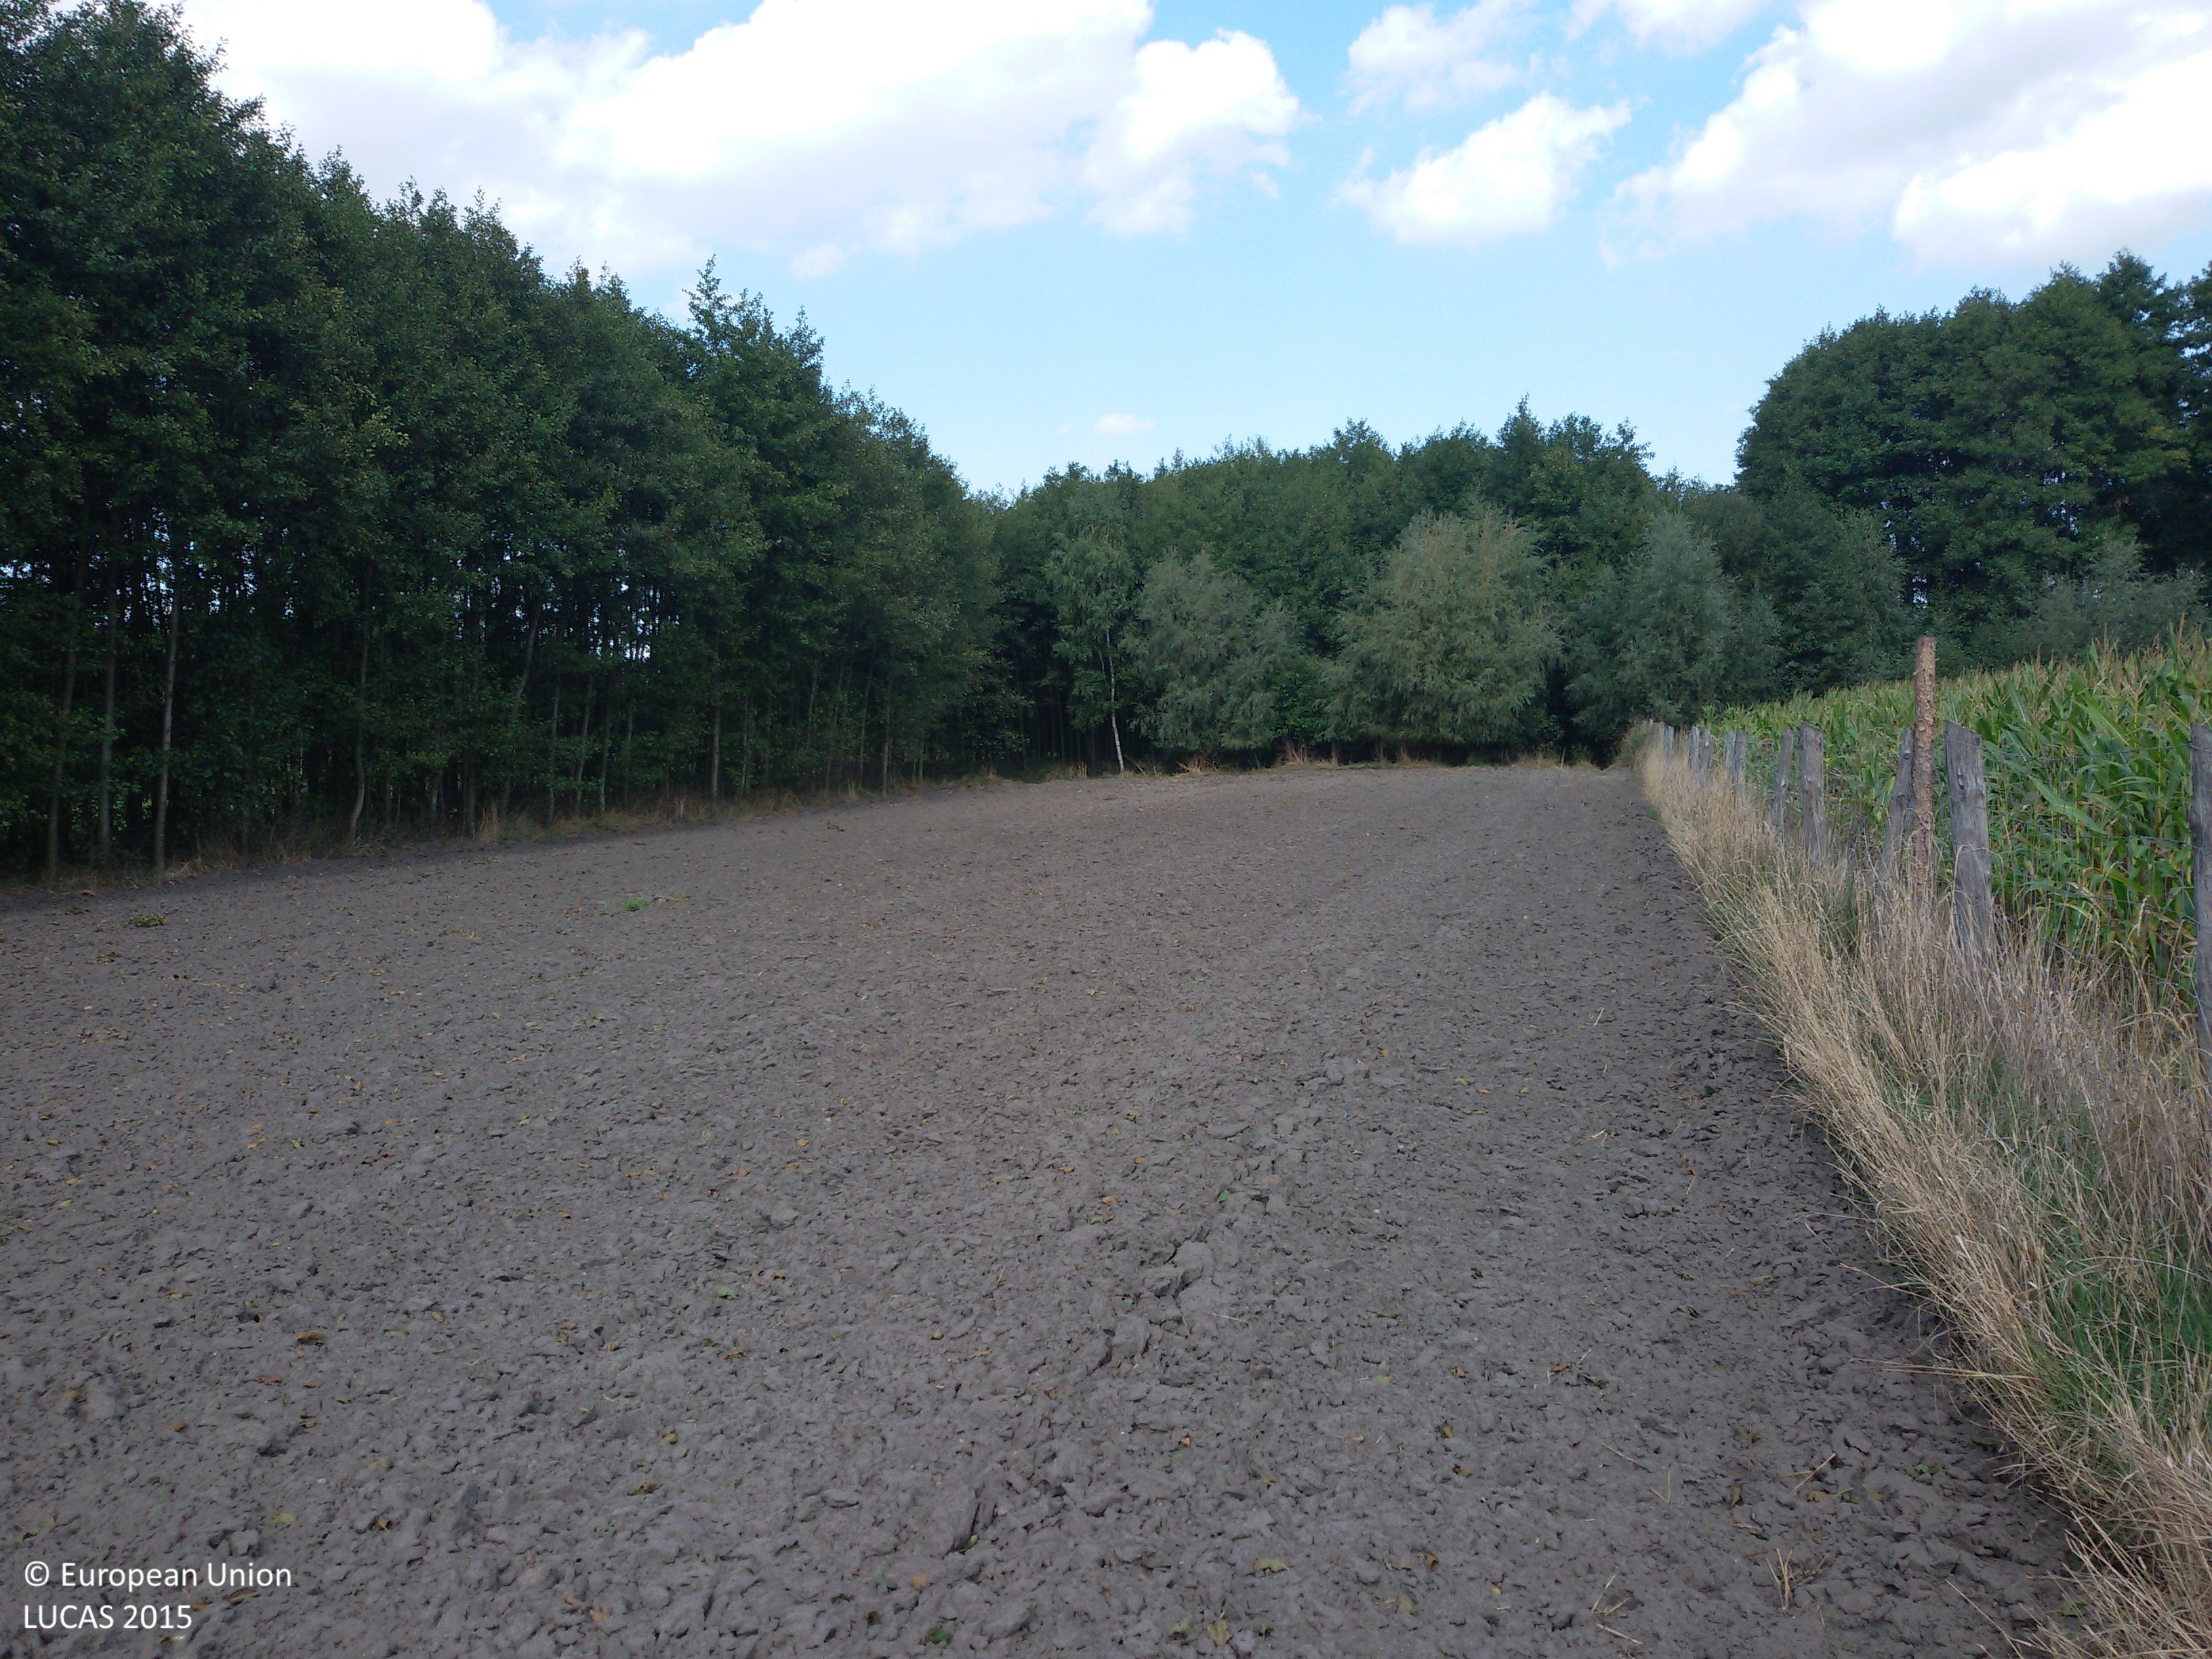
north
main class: Cropland
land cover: Maize
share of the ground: > 75 %
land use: Agriculture (excluding fallow land and kitchen gardens)
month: September
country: PL
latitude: 52.1289
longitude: 17.9474
